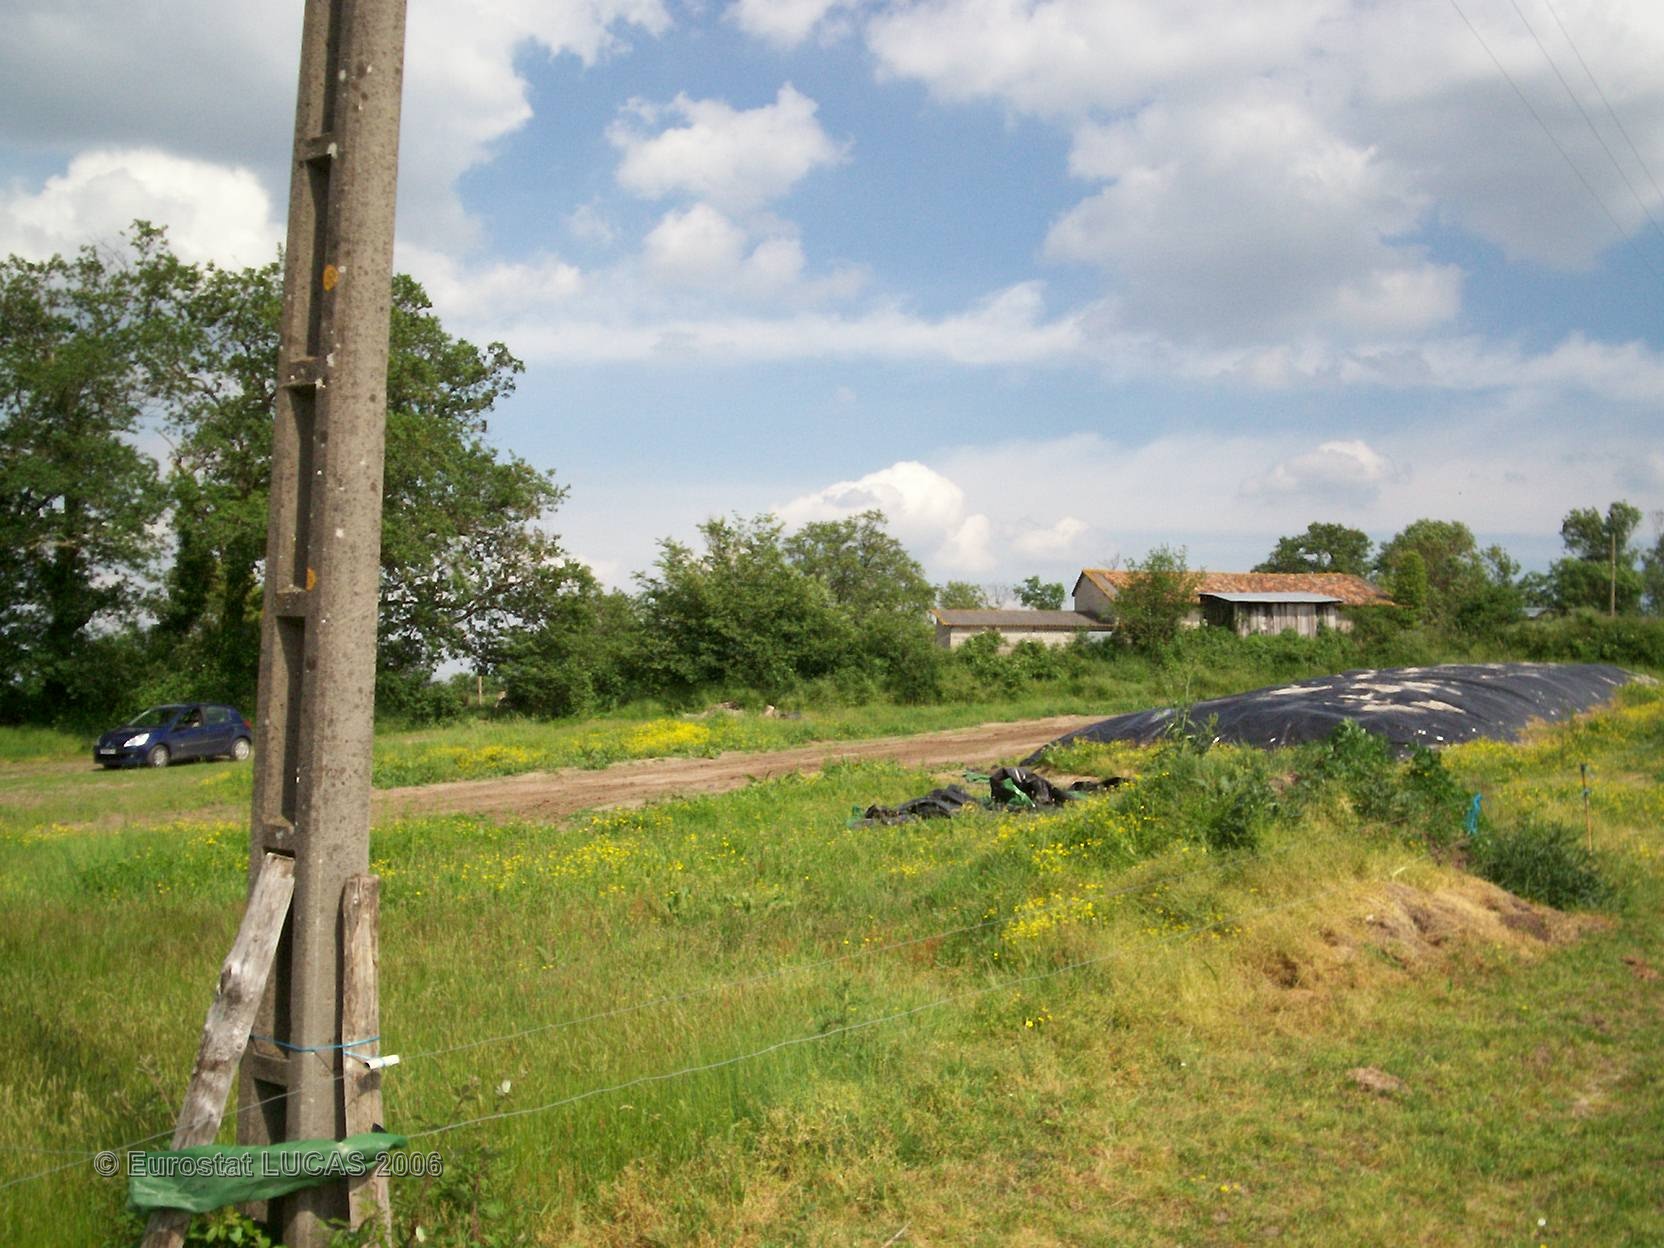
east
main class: Grassland
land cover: Grassland without tree/shrub cover
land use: Agriculture (excluding fallow land and kitchen gardens)
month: May
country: FR
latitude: 45.1304
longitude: -0.0730
